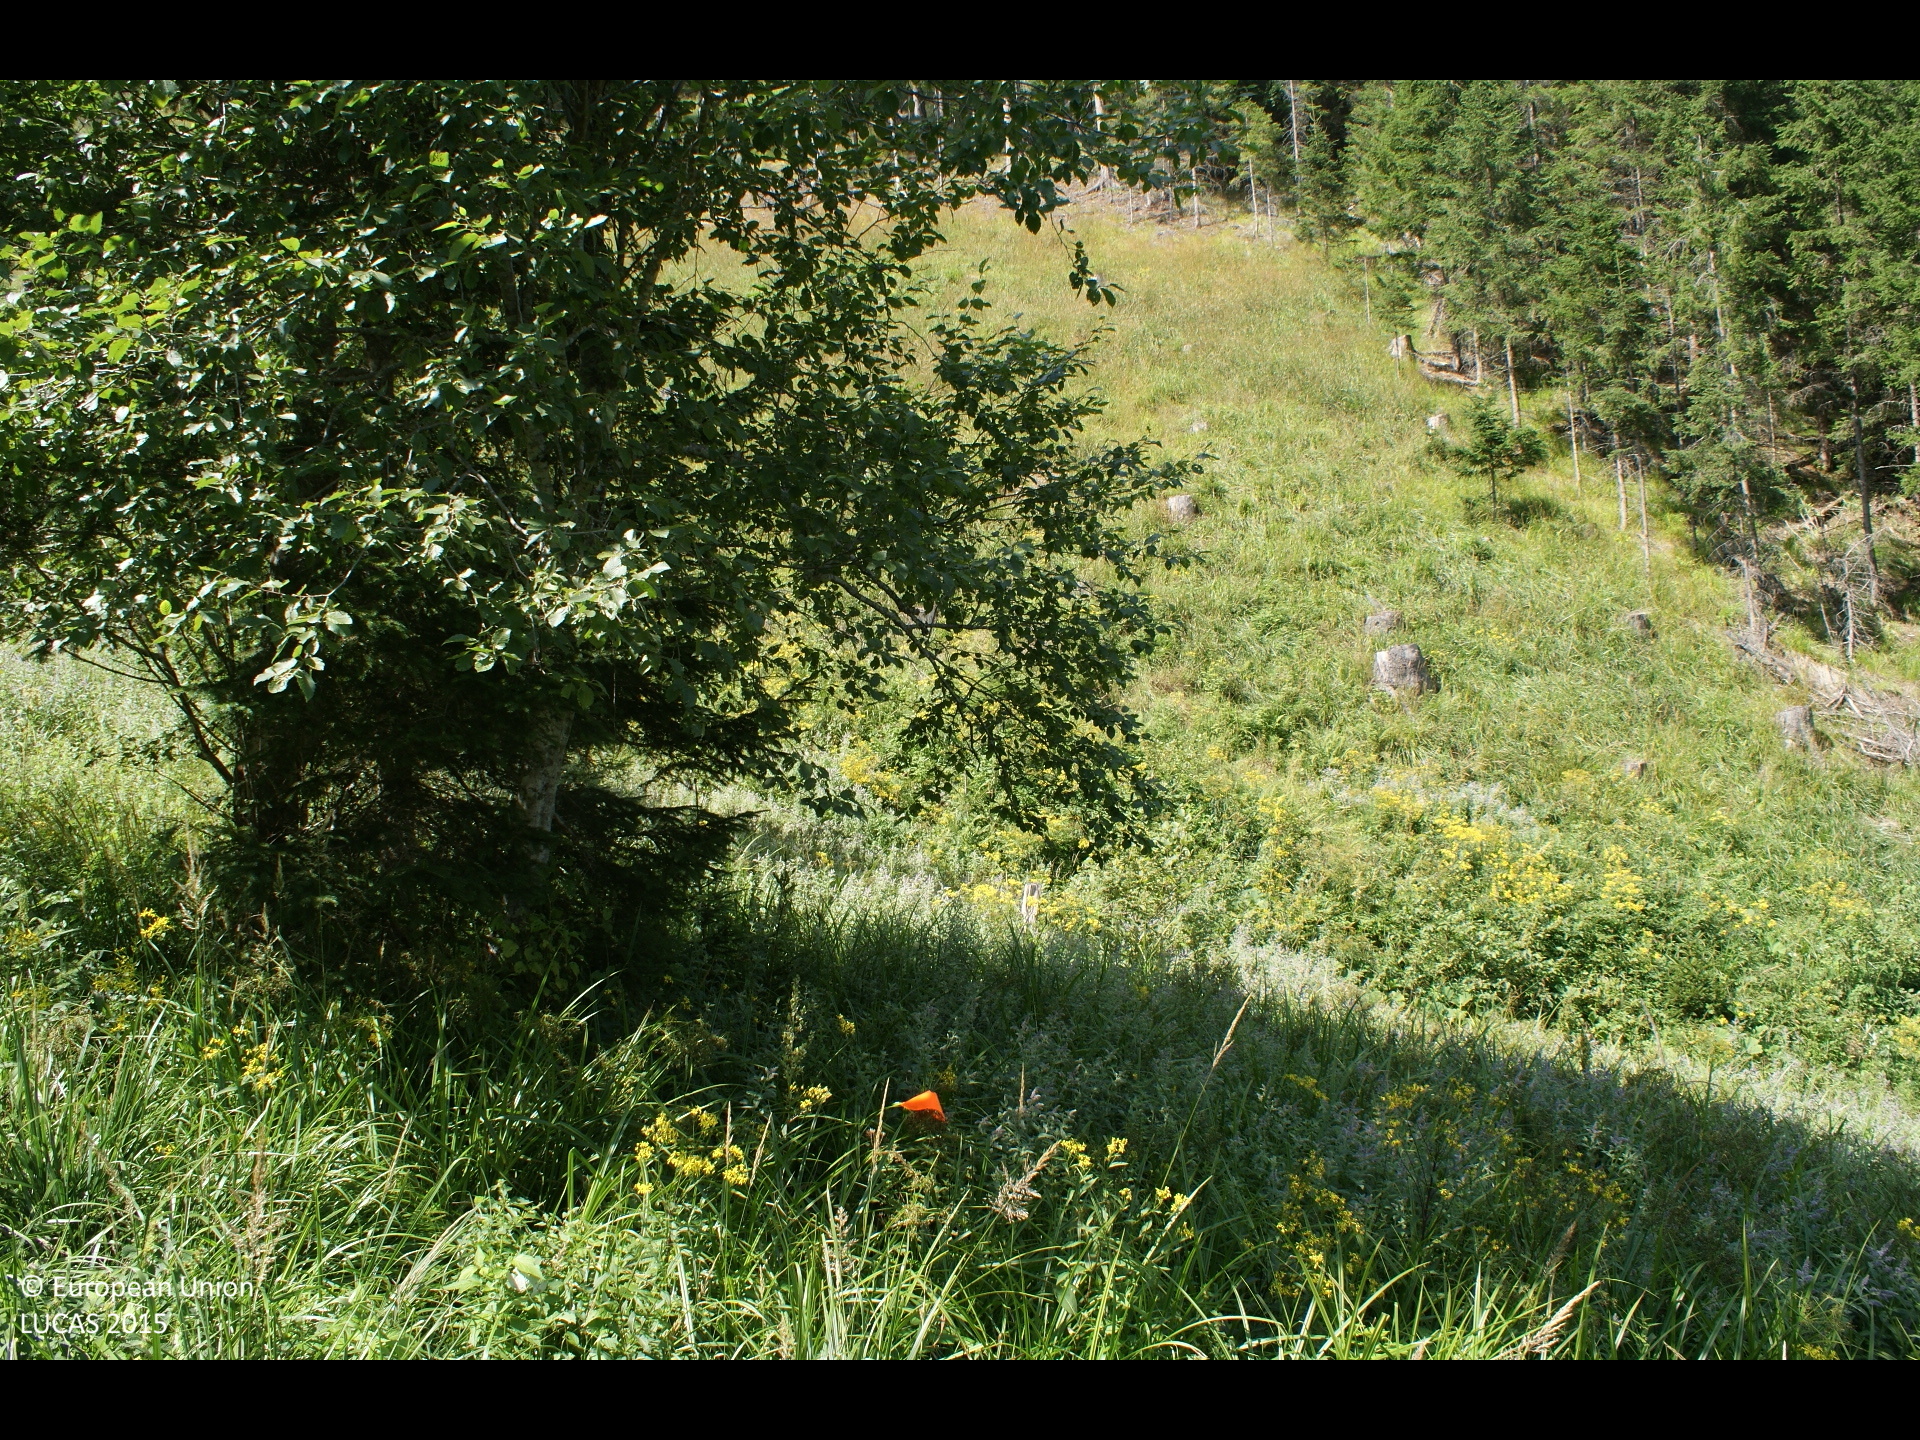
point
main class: Shrubland
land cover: Shrubland with sparse tree cover
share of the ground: > 75 %
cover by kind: herbaceous plants 55 %, shrubs 40 %, broadleaved forest trees 5 %
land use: Forestry
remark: Clear cut
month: August
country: AT
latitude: 47.6035
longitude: 15.4146
